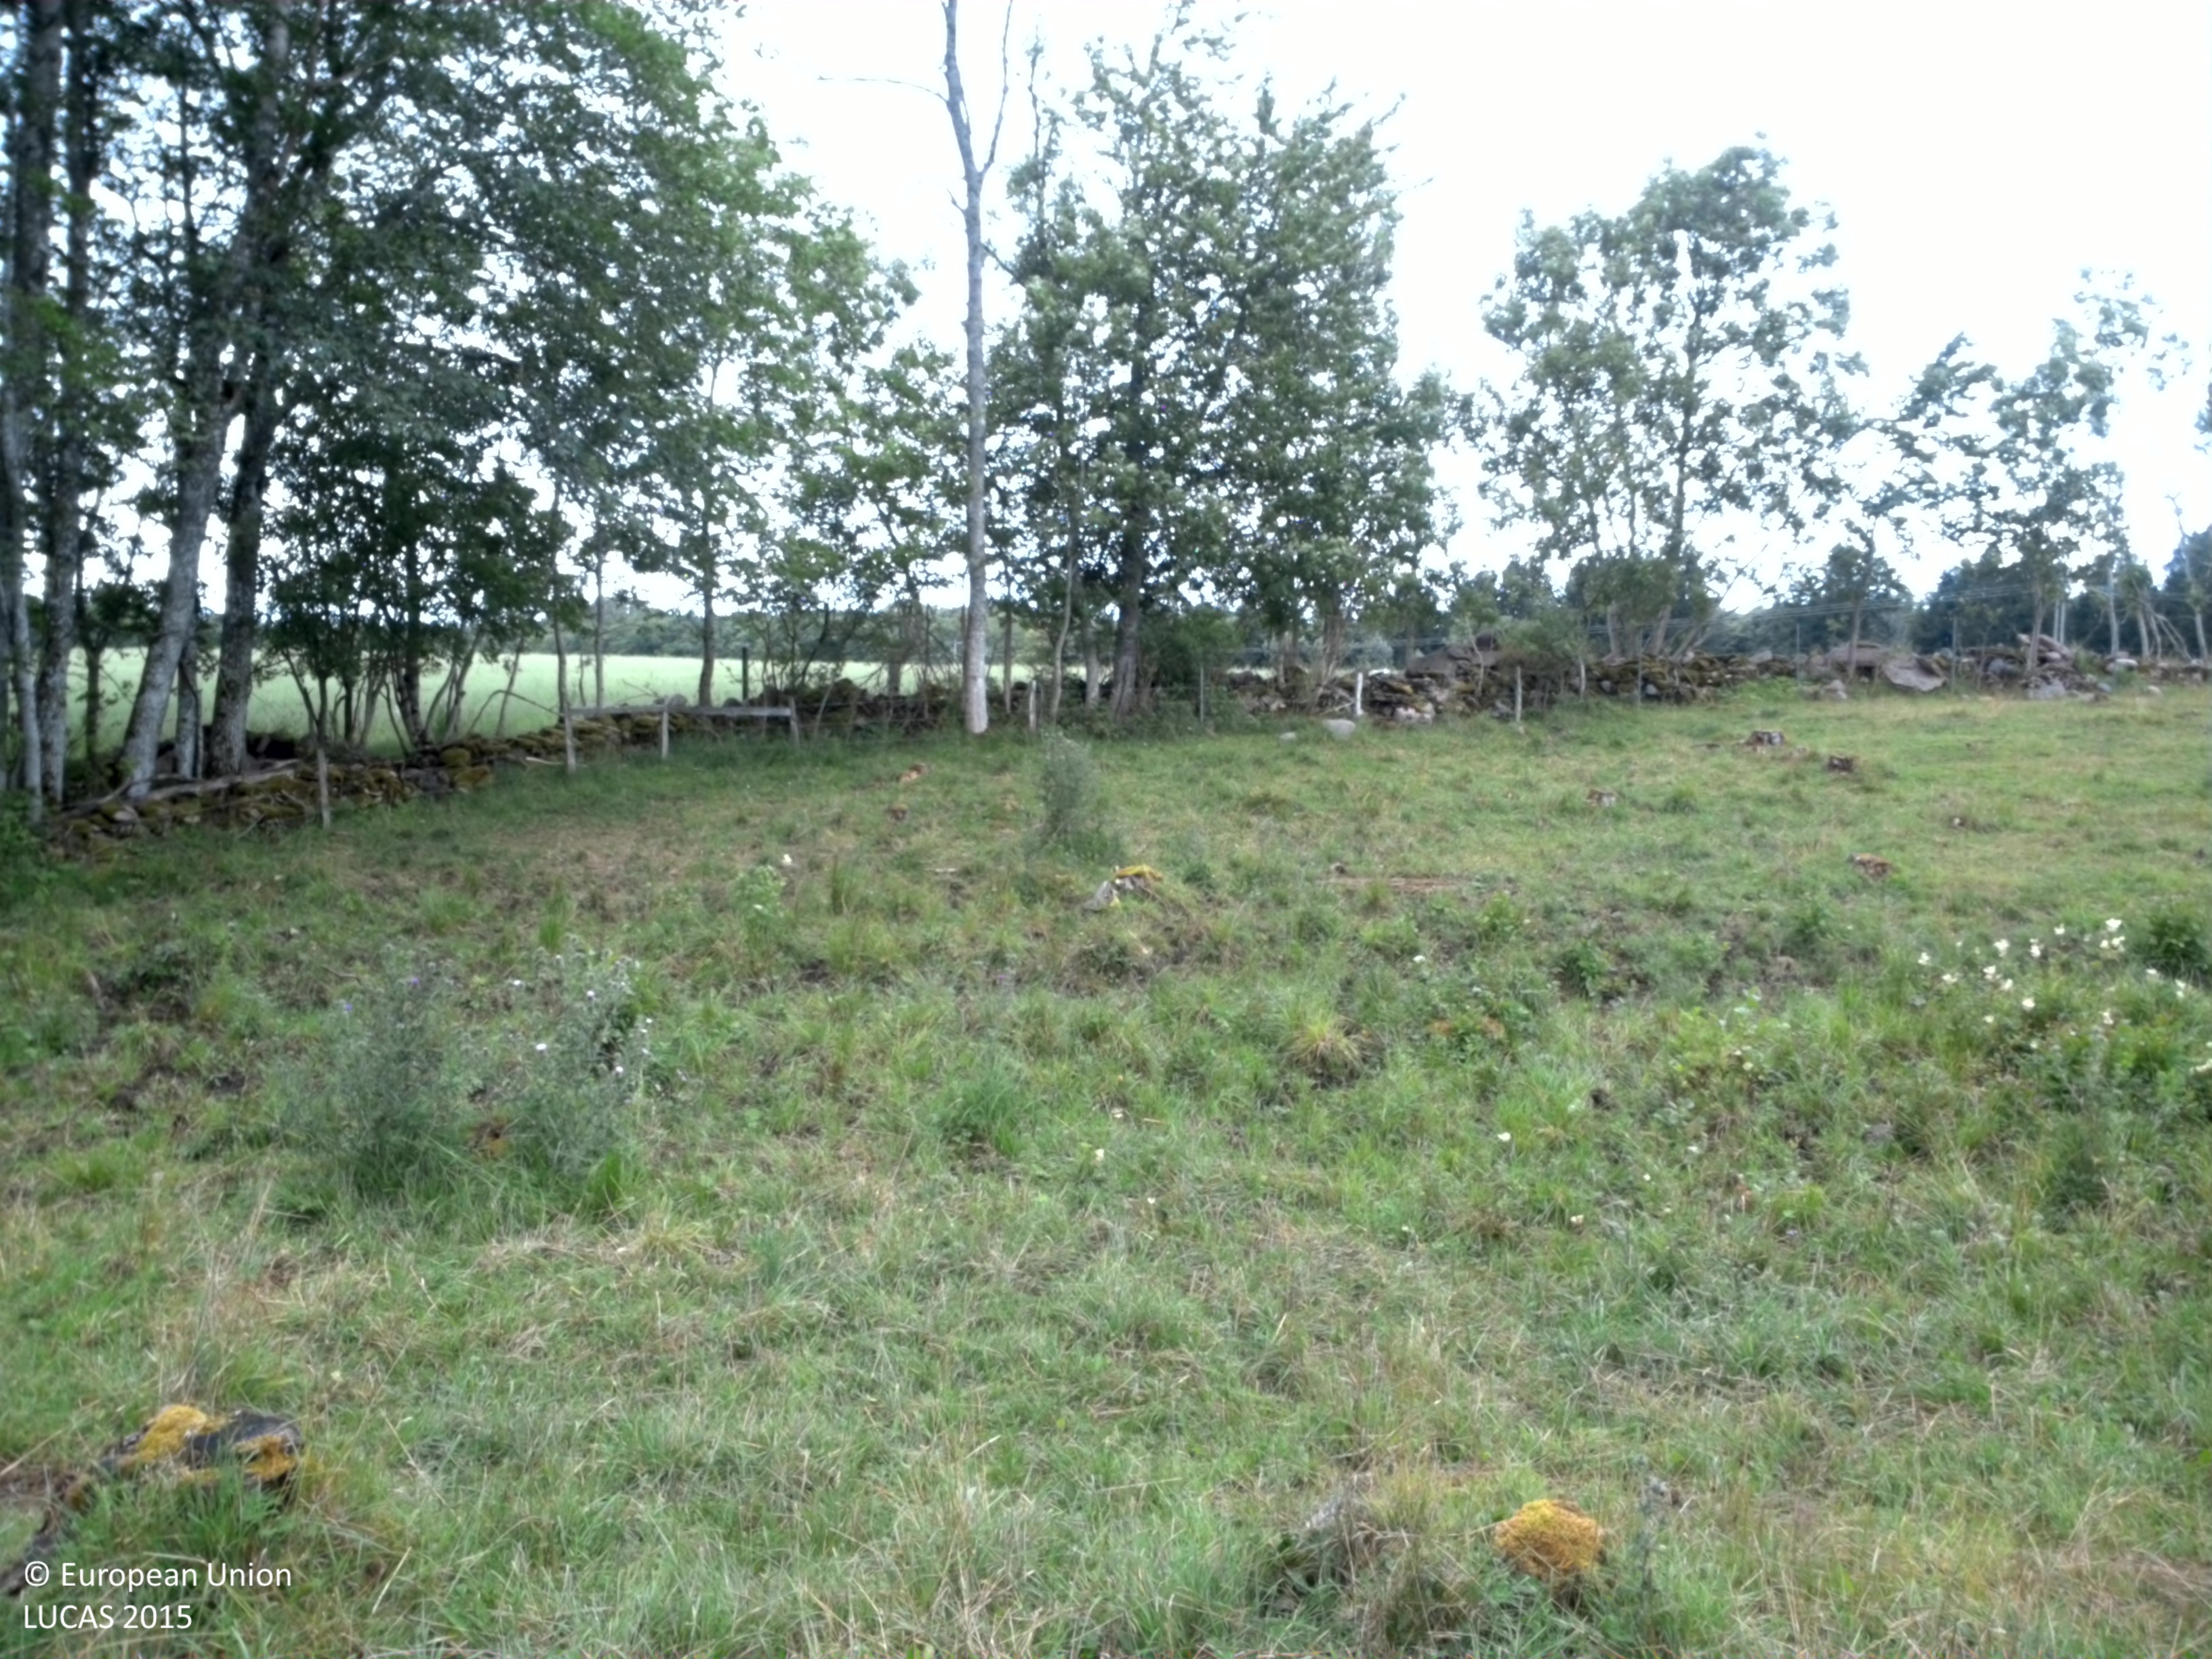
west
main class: Grassland
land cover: Grassland with sparse tree/shrub cover
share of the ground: > 75 %
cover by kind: herbaceous plants 90 %, broadleaved forest trees 5 %, shrubs 5 %
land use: Agriculture (excluding fallow land and kitchen gardens)
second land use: Amenities, museums, leisure
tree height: > 5 m
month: July
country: SE
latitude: 58.5731
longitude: 13.3812
